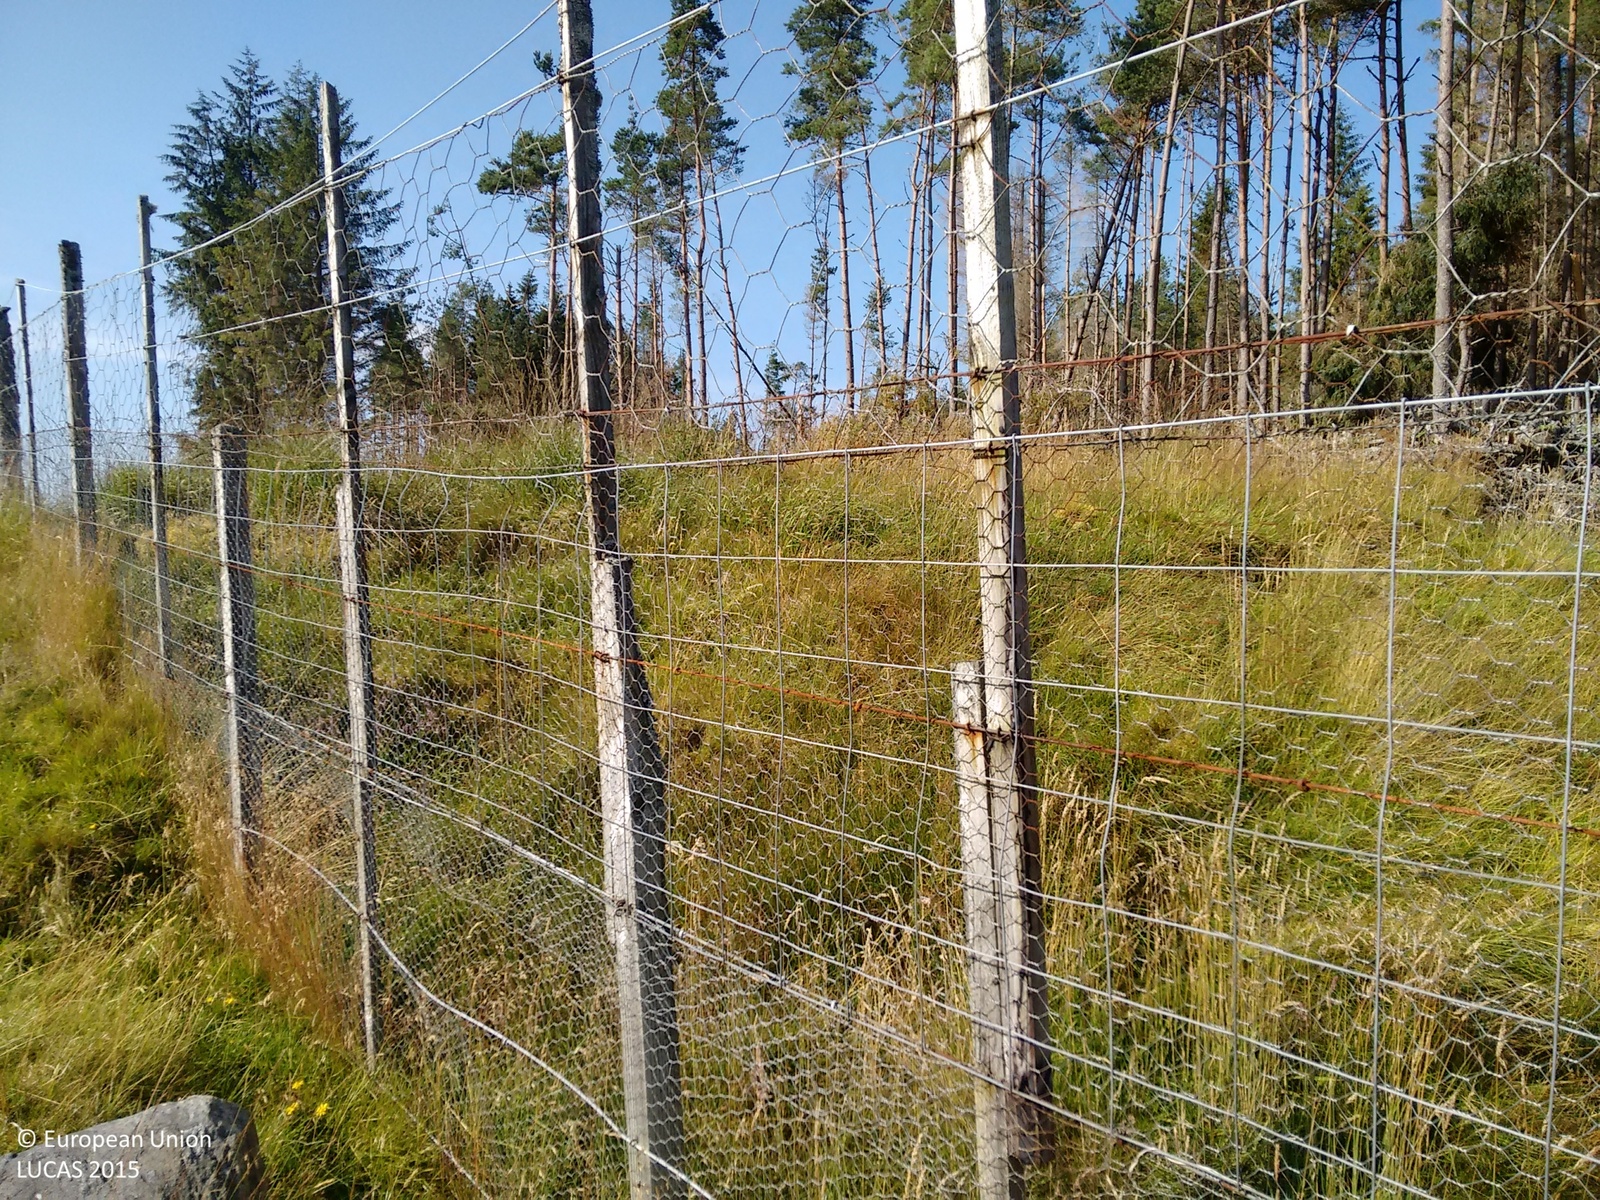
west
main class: Woodland
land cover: Pine dominated coniferous woodland
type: hemiboreal forest and nemoral coniferous forest and mixed broadleaved-coniferous forest
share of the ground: > 75 %
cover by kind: coniferous forest trees 100 %
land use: Forestry
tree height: > 5 m
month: September
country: GB
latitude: 58.3525
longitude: -4.2461
